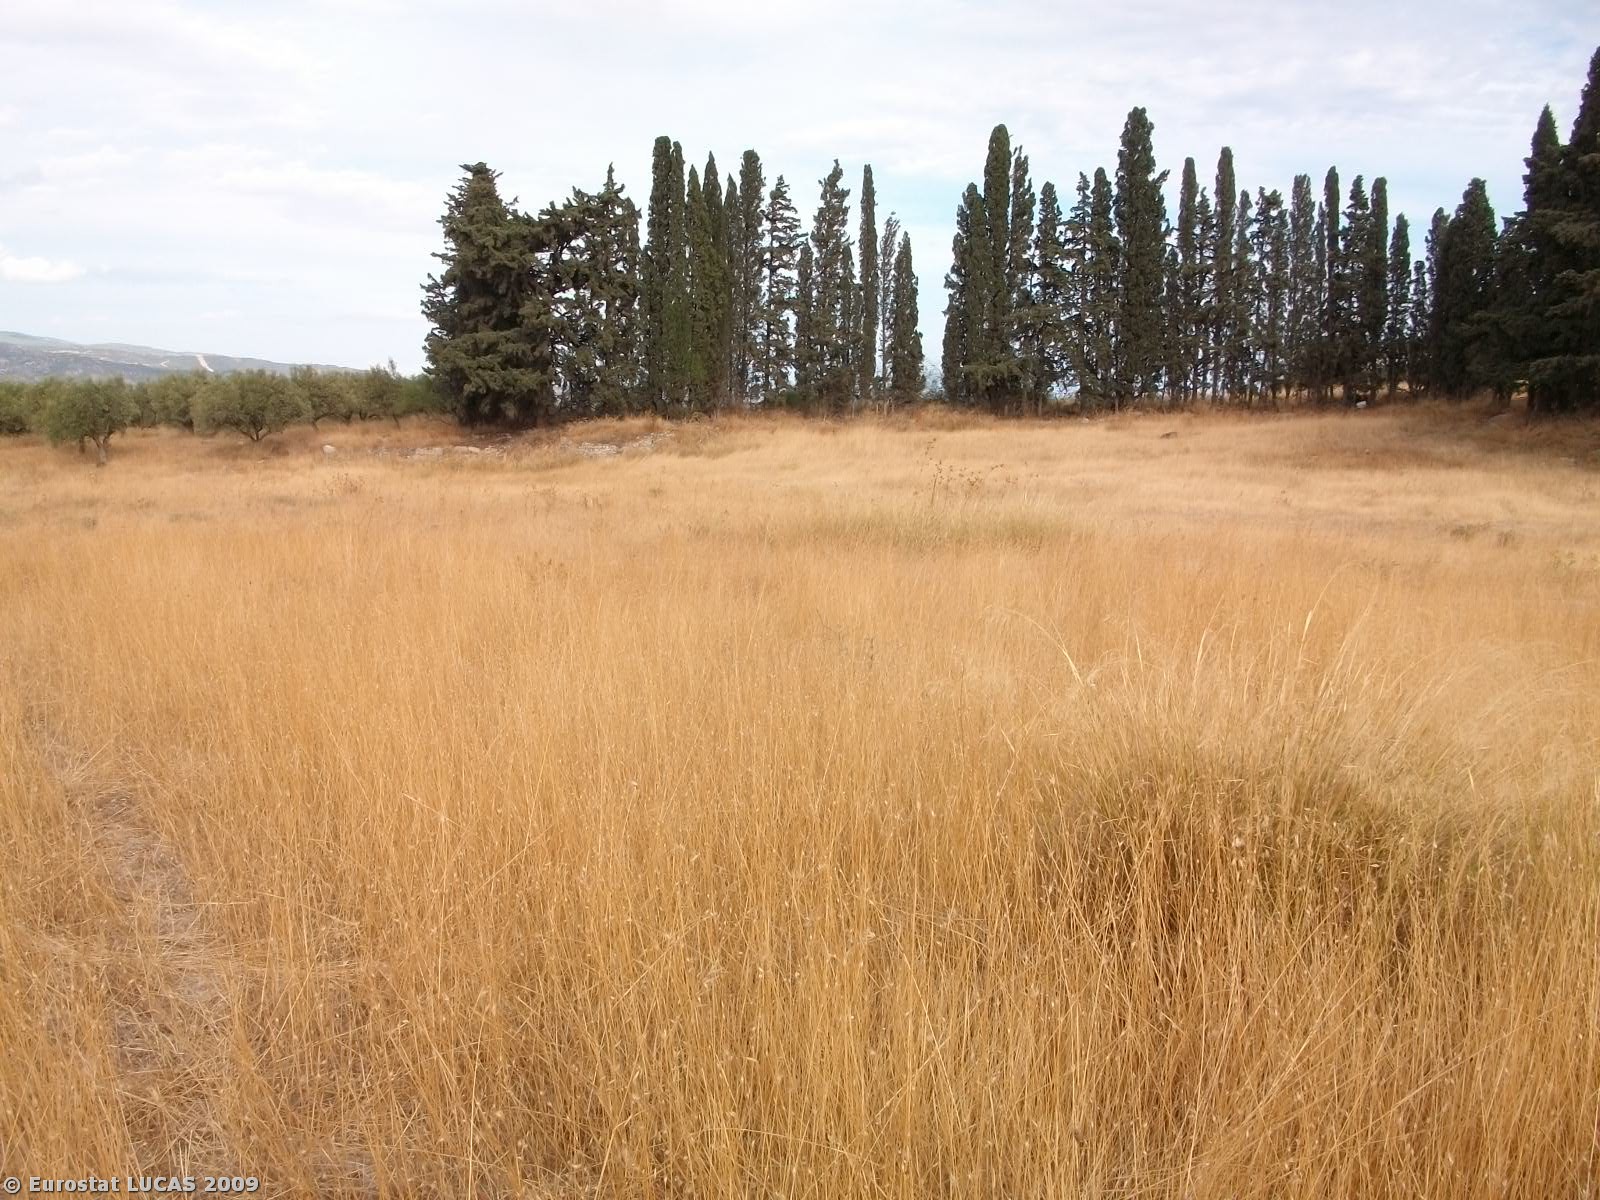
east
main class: Grassland
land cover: Spontaneously vegetated surfaces
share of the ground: > 75 %
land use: Fallow land
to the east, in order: Spontaneously vegetated surfaces; Fences; Abandoned hedges; Grassland with sparse tree/shrub cover; Grassland without tree/shrub cover; Other citrus fruit; Grassland with sparse tree/shrub cover; Broadleaved woodland; Shrubland with sparse tree cover
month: September
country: GR
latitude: 37.9152
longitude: 22.9966
